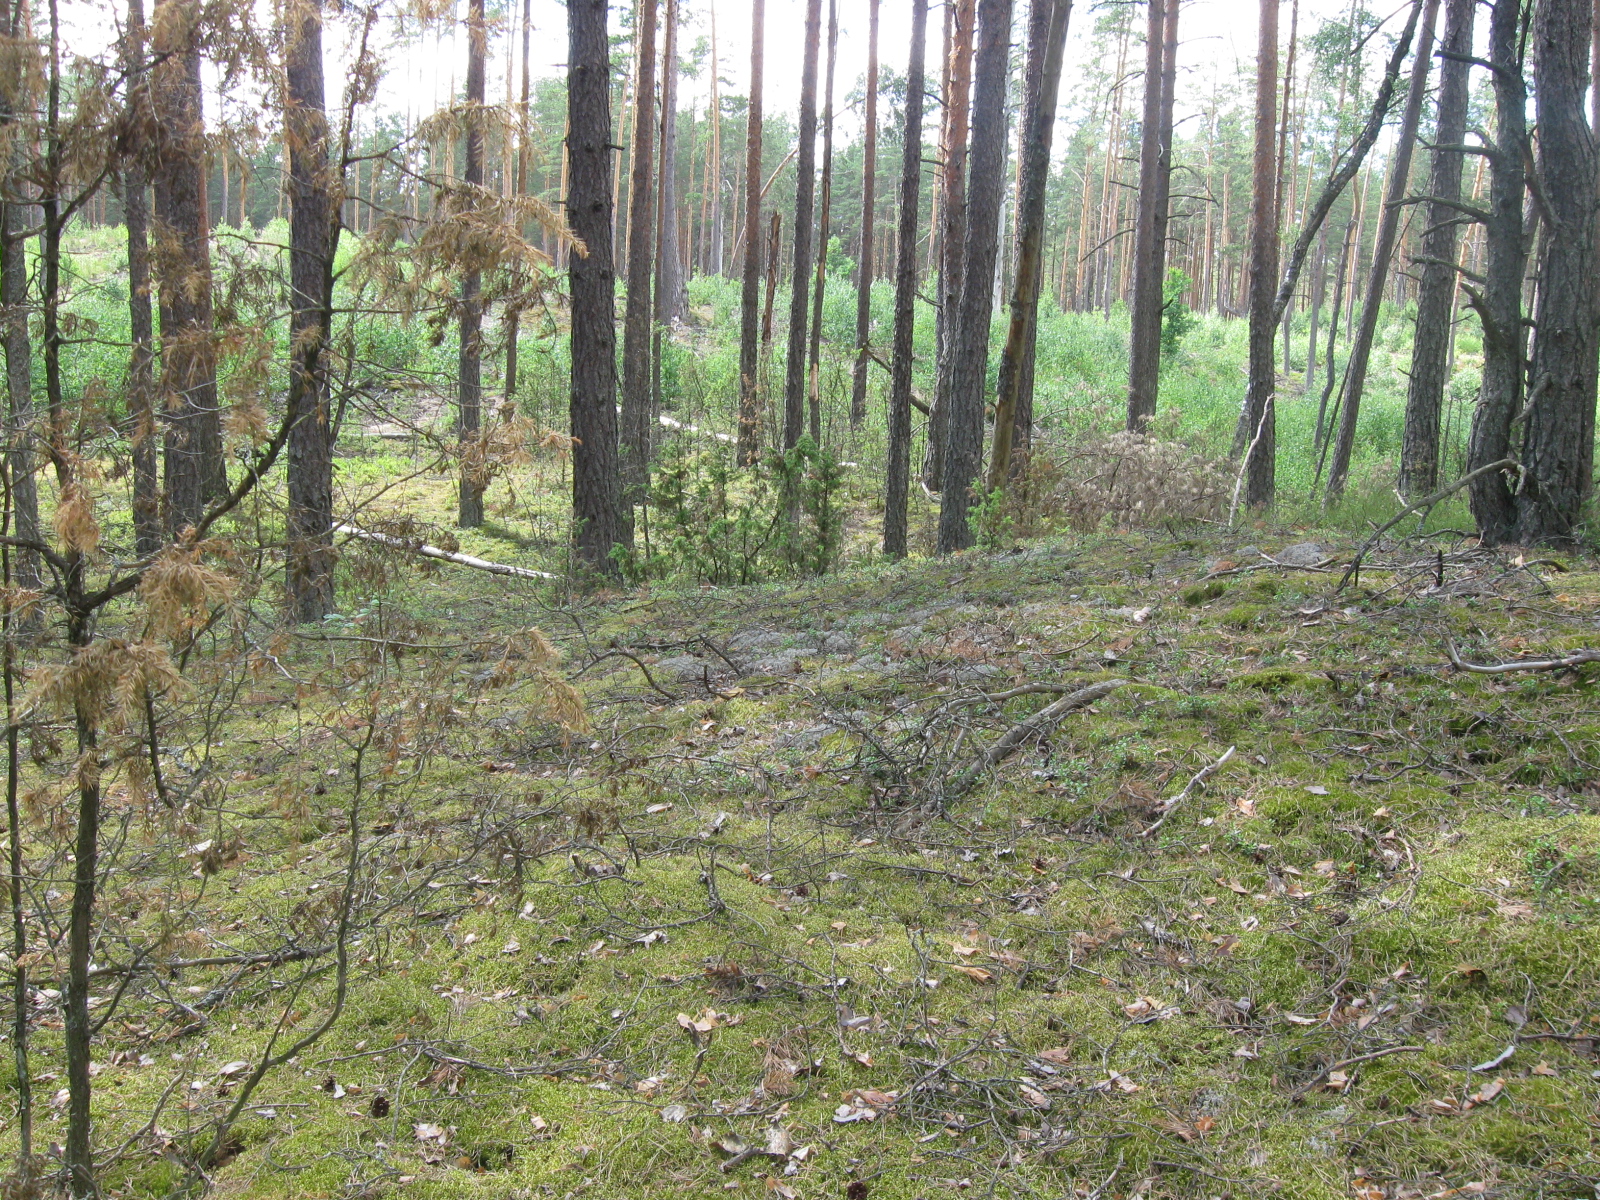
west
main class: Woodland
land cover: Pine dominated coniferous woodland
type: hemiboreal forest and nemoral coniferous forest and mixed broadleaved-coniferous forest
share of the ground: > 75 %
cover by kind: coniferous forest trees 95 %, lichens and mosses 5 %
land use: Forestry
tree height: > 5 m
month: June
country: LT
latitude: 54.0964
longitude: 24.4925
